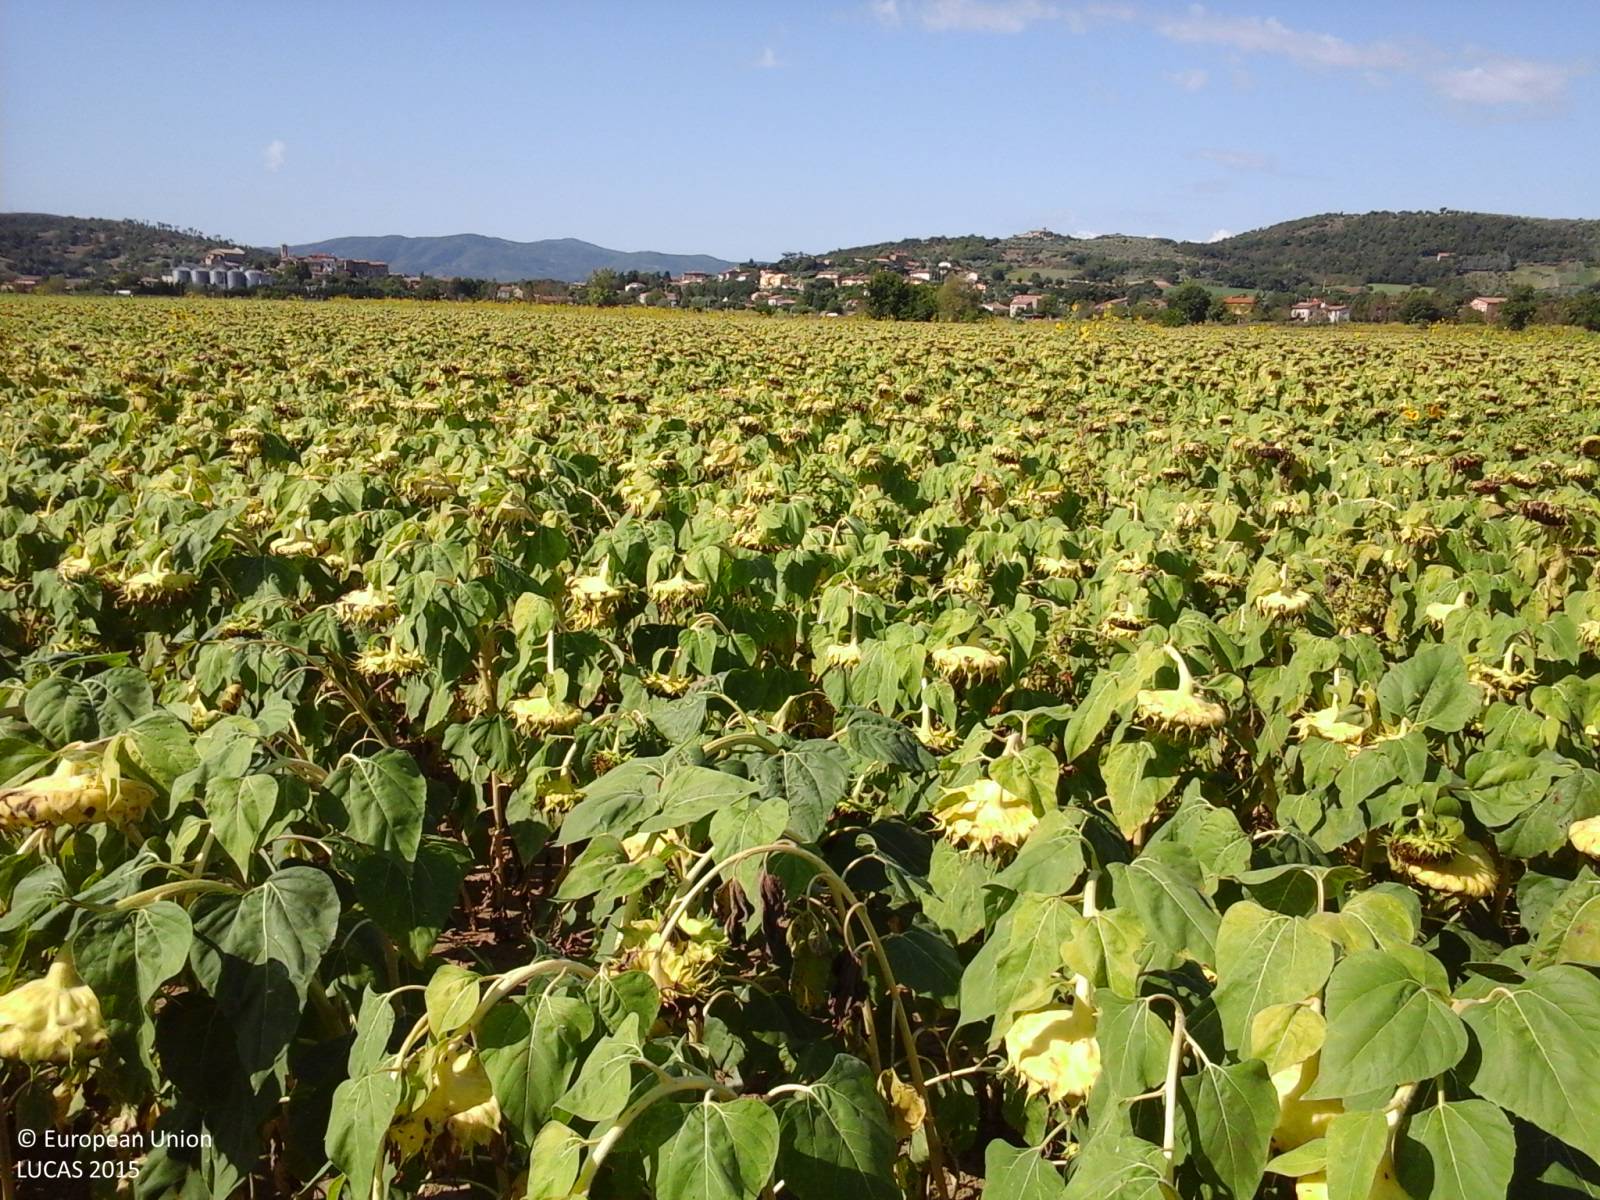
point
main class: Cropland
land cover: Sunflower
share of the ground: > 75 %
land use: Agriculture (excluding fallow land and kitchen gardens)
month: September
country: IT
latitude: 43.0262
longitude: 12.2636
